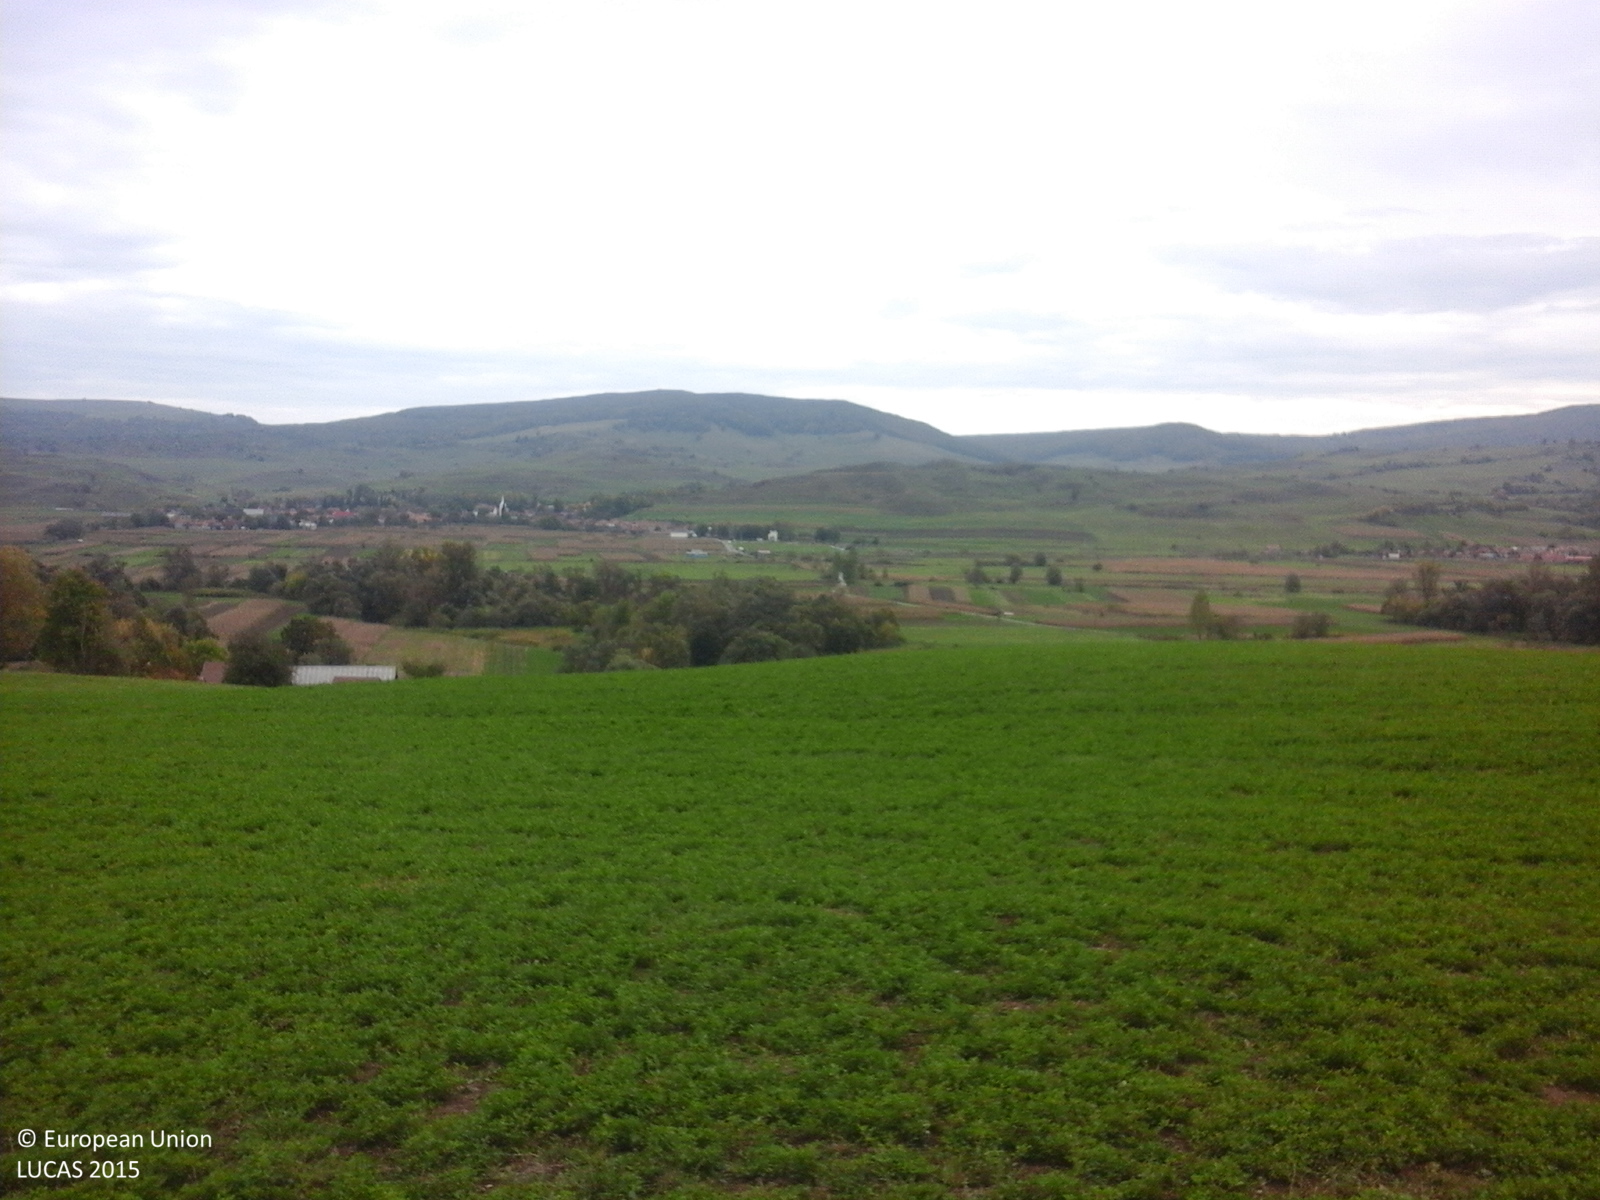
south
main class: Grassland
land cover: Grassland without tree/shrub cover
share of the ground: > 75 %
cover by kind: herbaceous plants 100 %
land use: Agriculture (excluding fallow land and kitchen gardens)
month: October
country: RO
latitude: 46.2658
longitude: 25.1895
